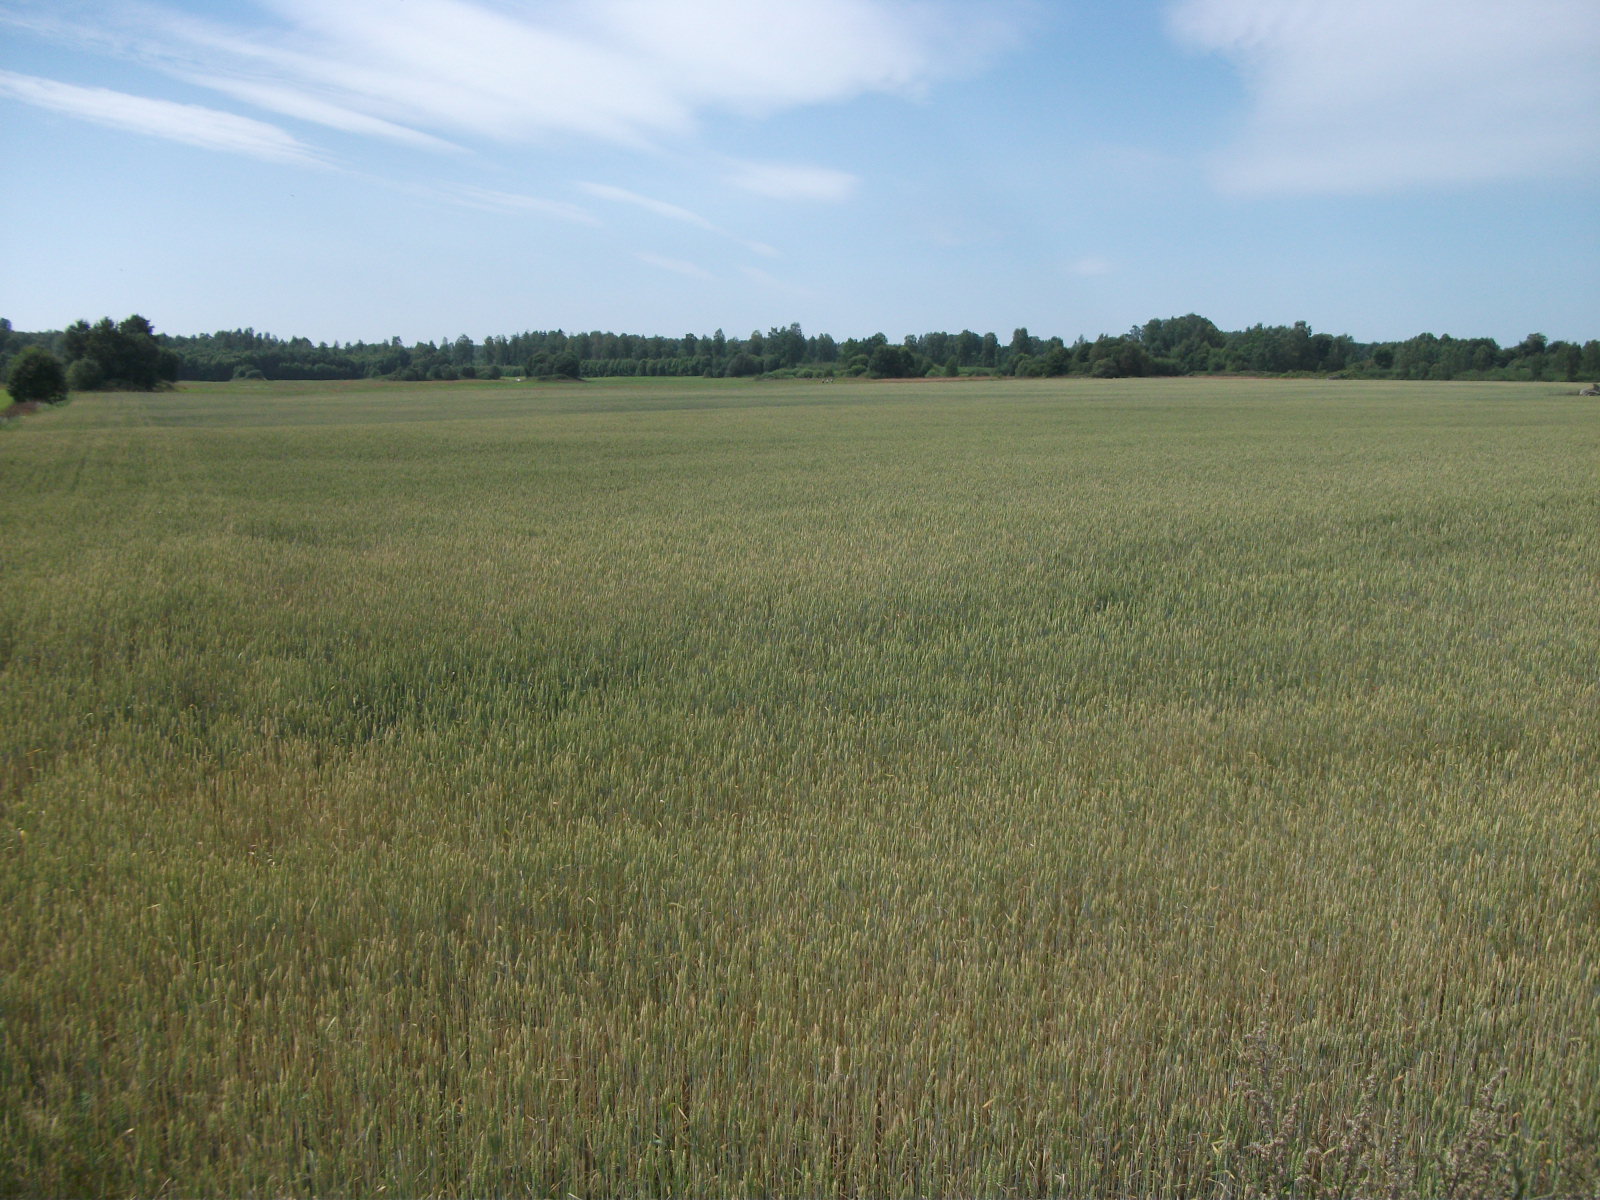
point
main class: Cropland
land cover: Common wheat
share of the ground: > 75 %
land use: Agriculture (excluding fallow land and kitchen gardens)
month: August
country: LV
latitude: 57.1236
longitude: 26.7183
